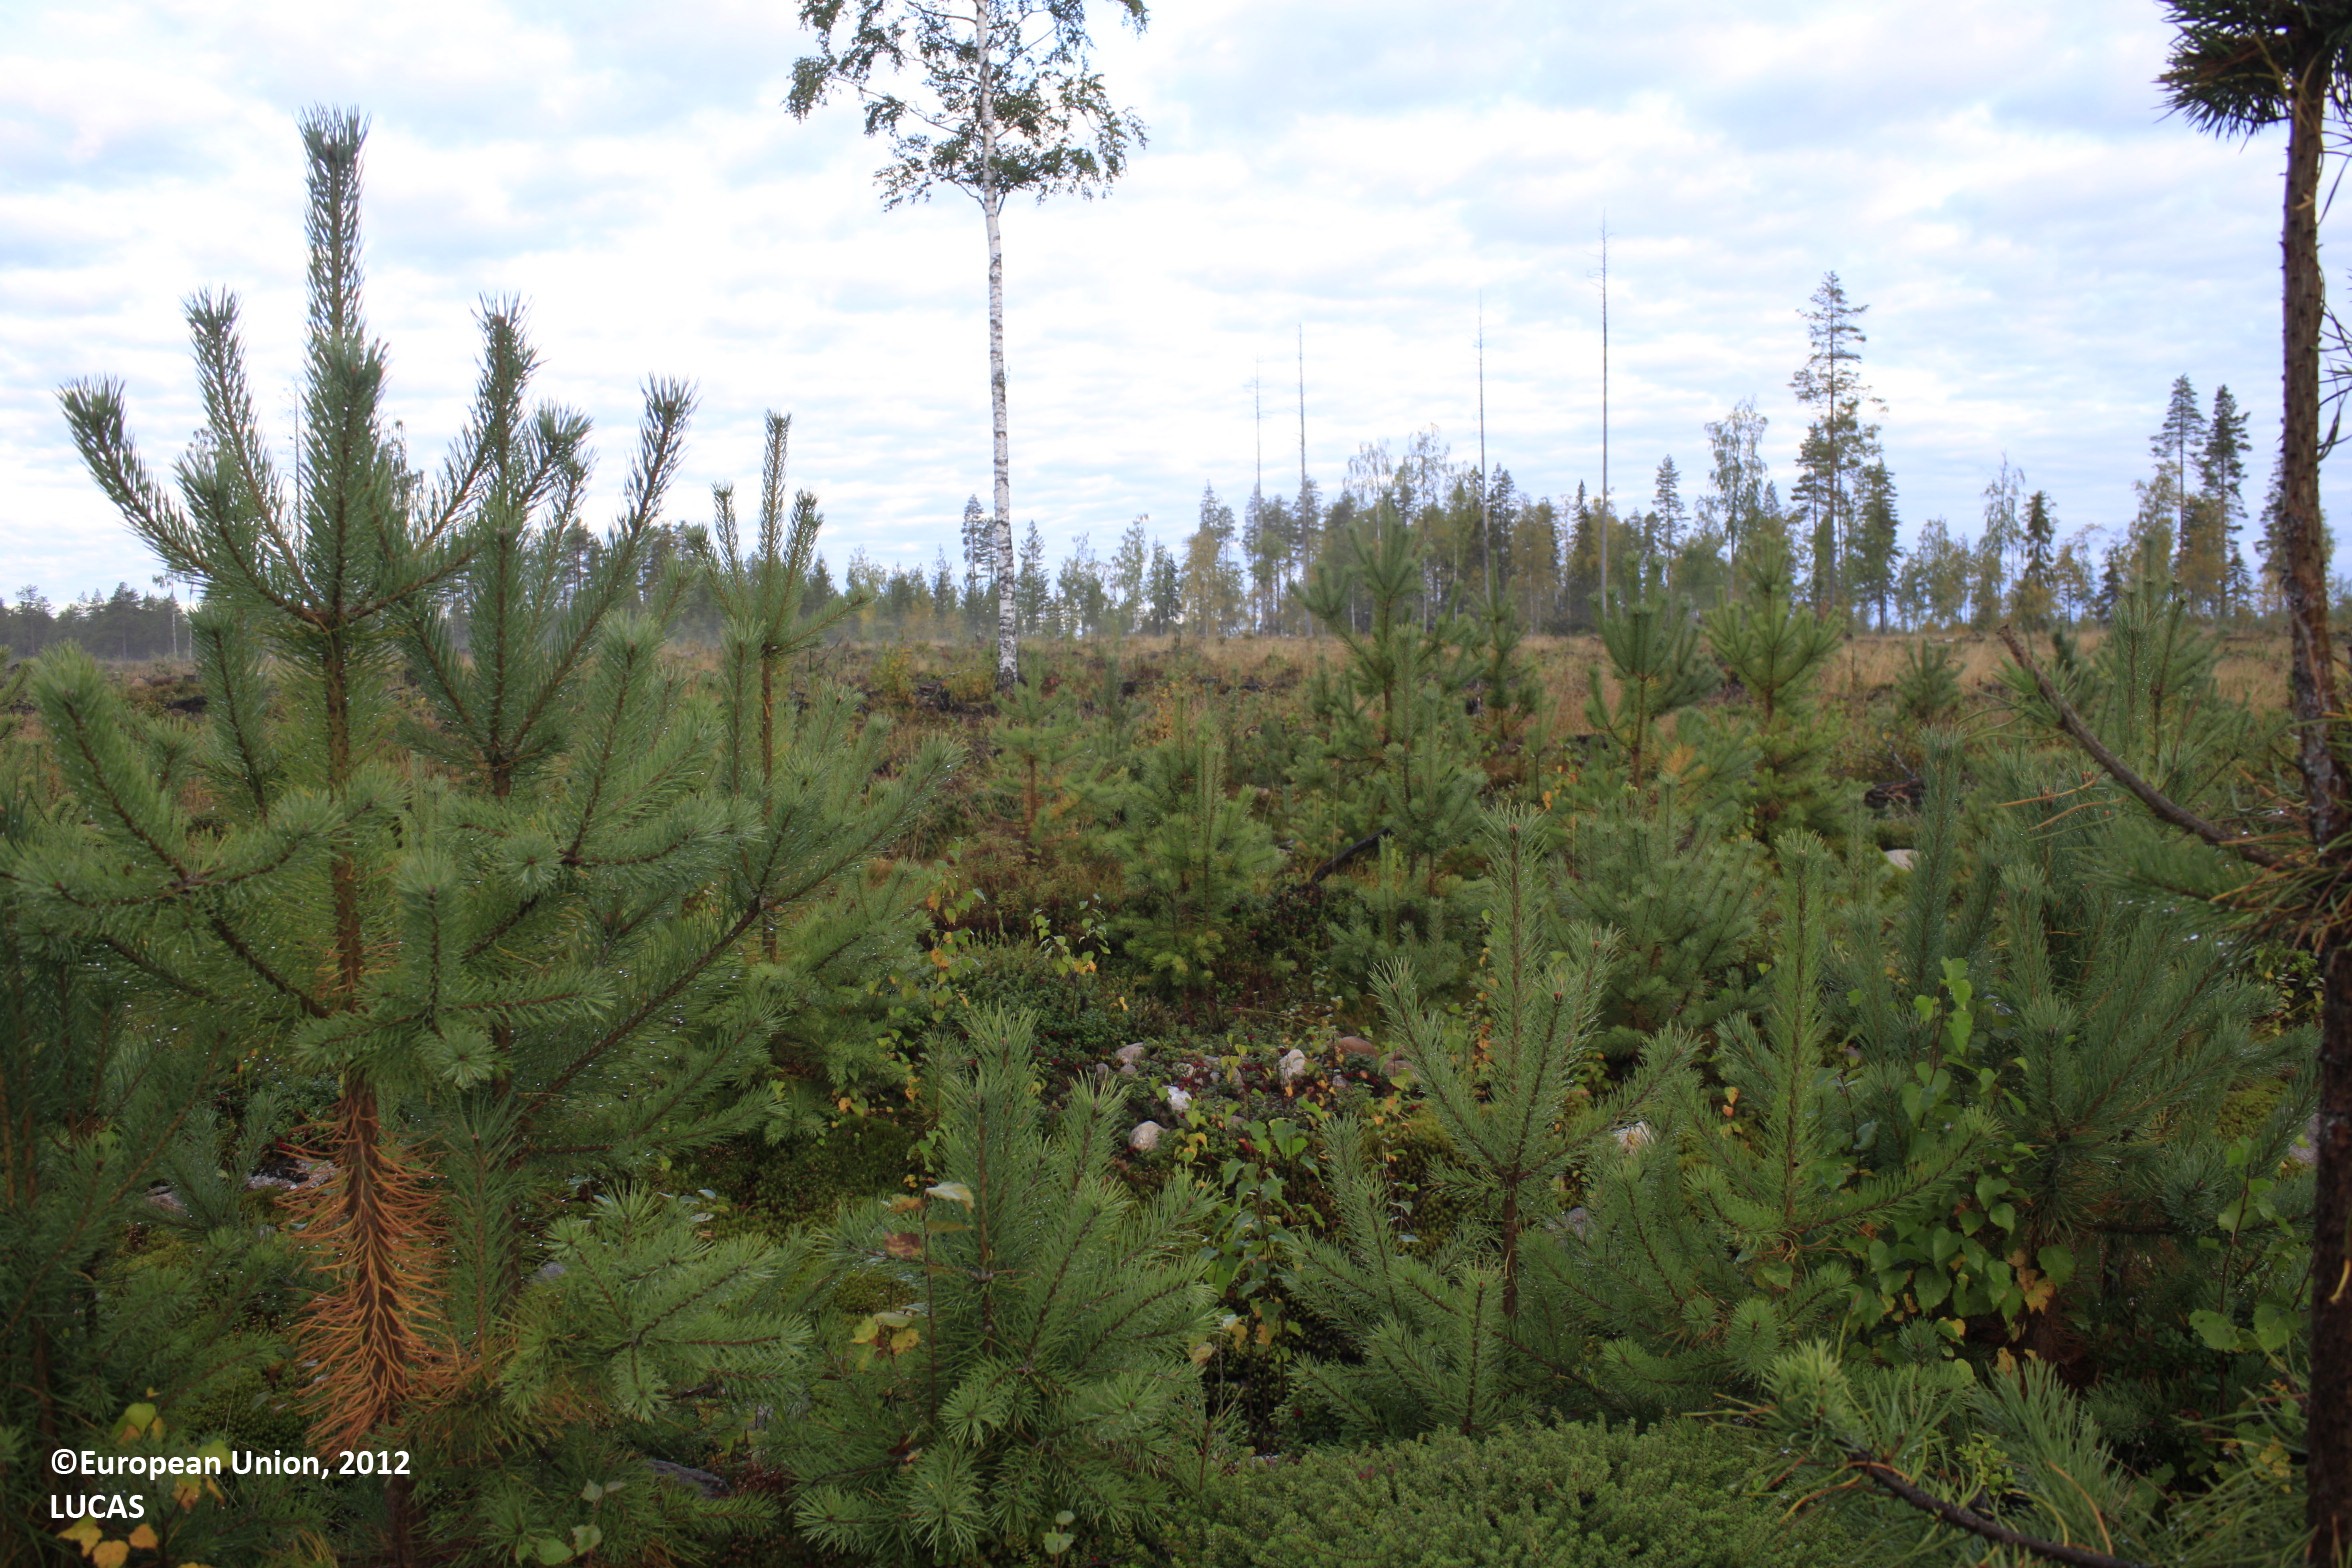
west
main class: Woodland
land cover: Pine dominated coniferous woodland
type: boreal forest
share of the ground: 25 - 50 %
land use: Forestry
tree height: < 5 m
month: September
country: FI
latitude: 65.6193
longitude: 26.7137
